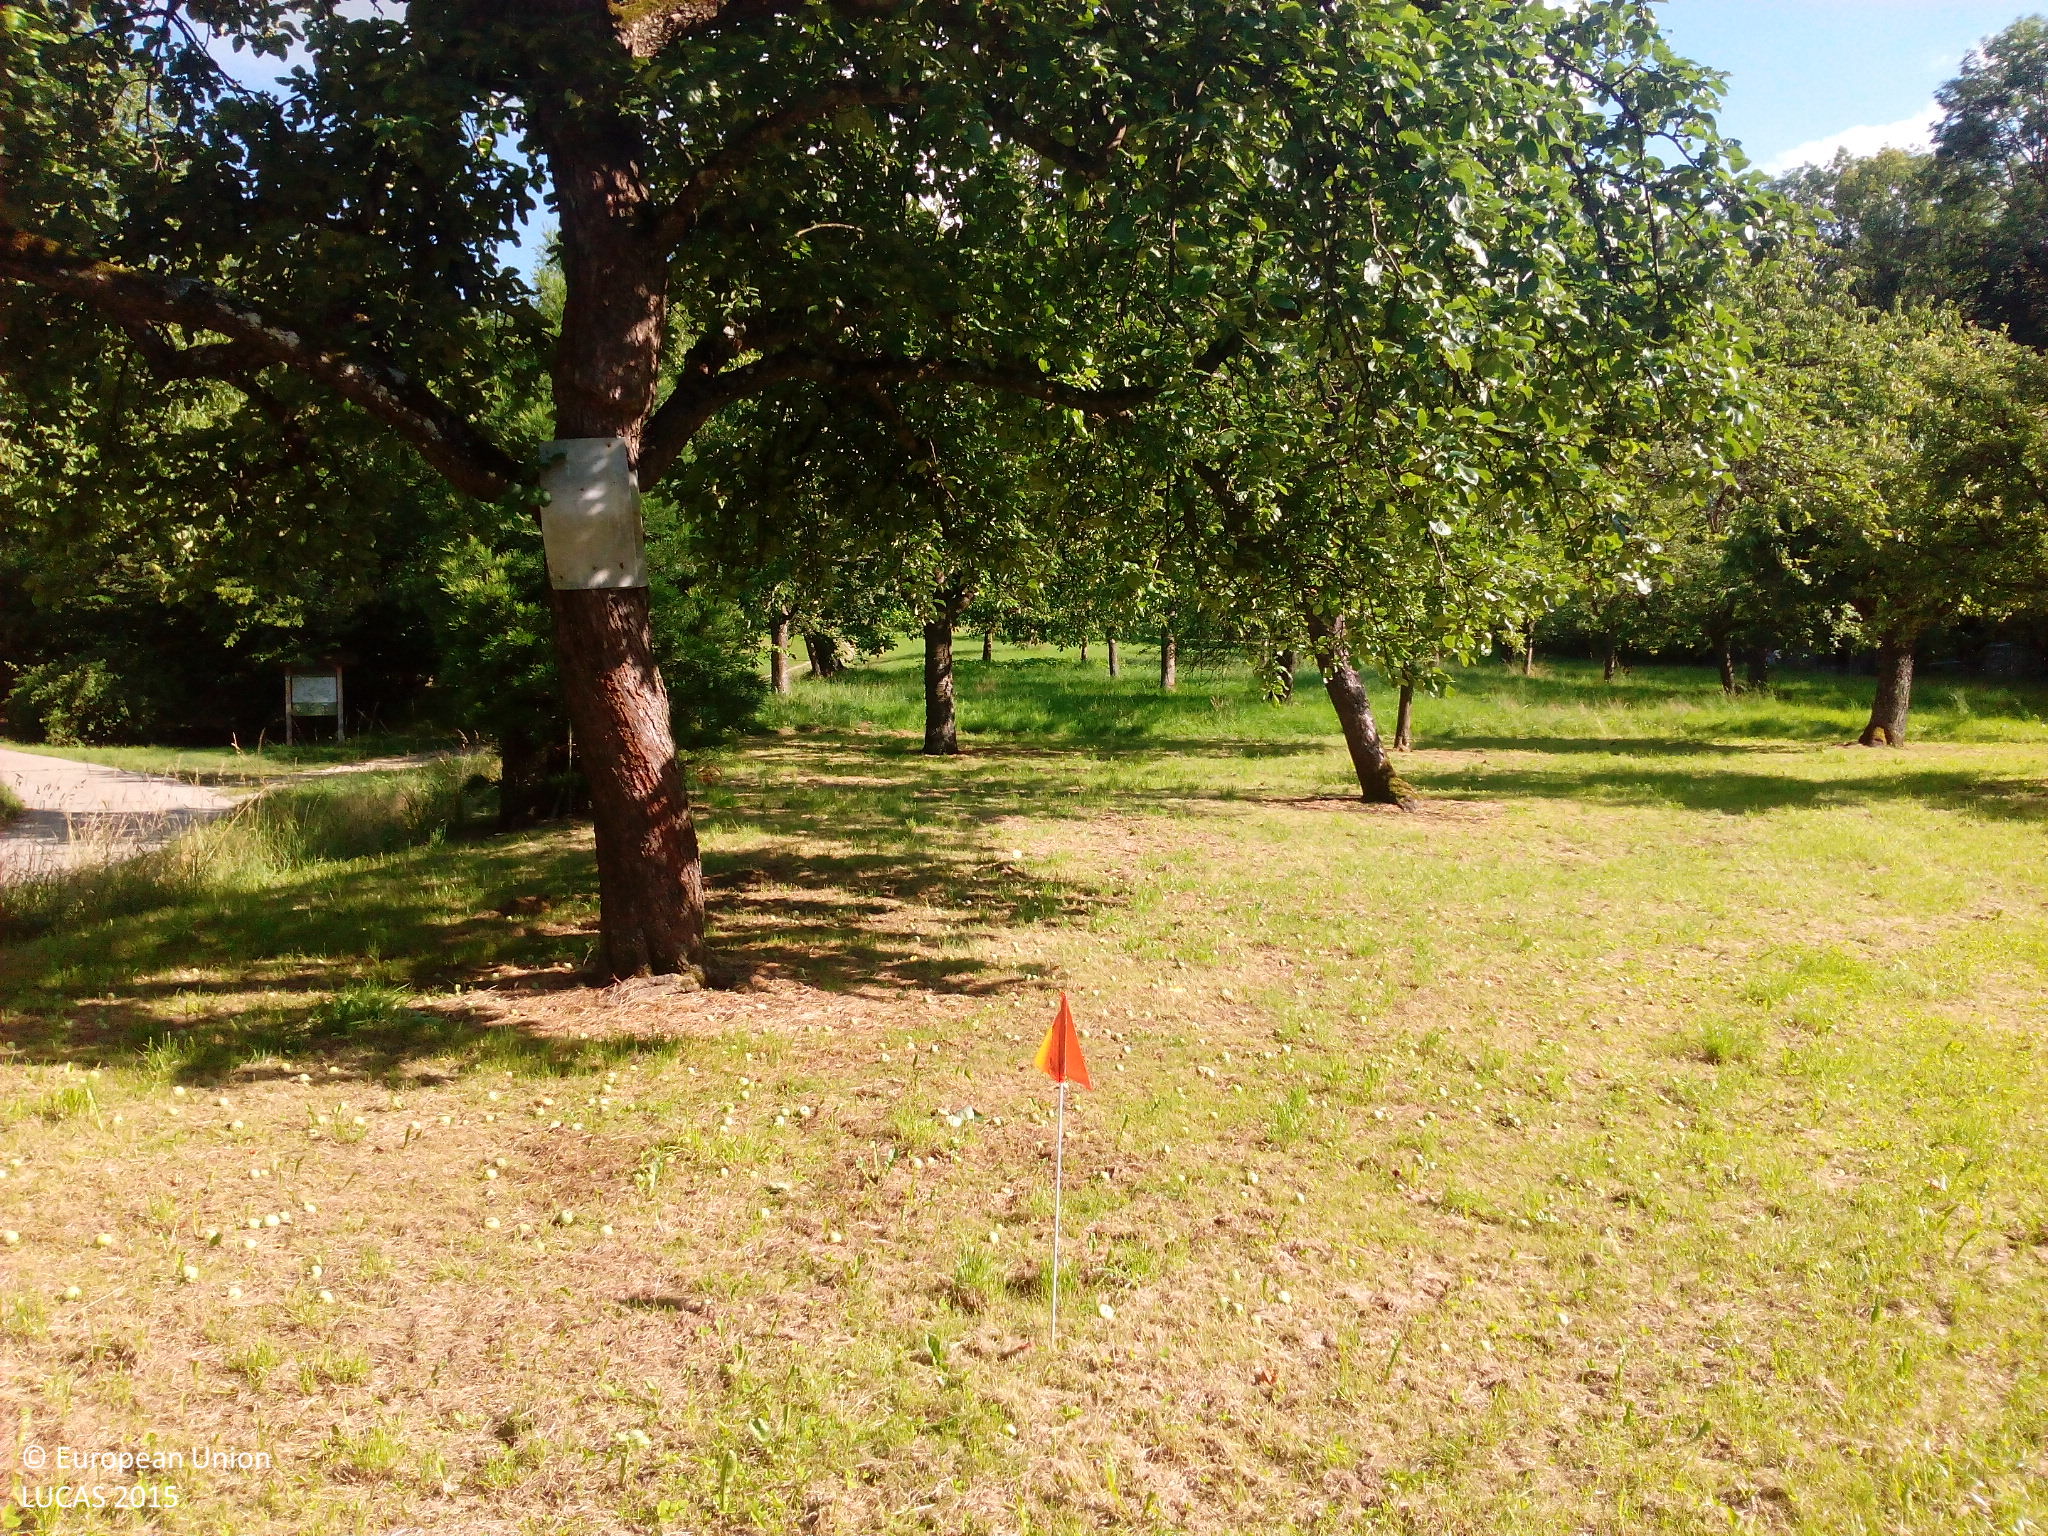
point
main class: Cropland
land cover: Apple fruit
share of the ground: 25 - 50 %
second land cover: Grassland without tree/shrub cover
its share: 50 - 75 %
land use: Agriculture (excluding fallow land and kitchen gardens)
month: June
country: DE
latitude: 48.5637
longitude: 9.3905
